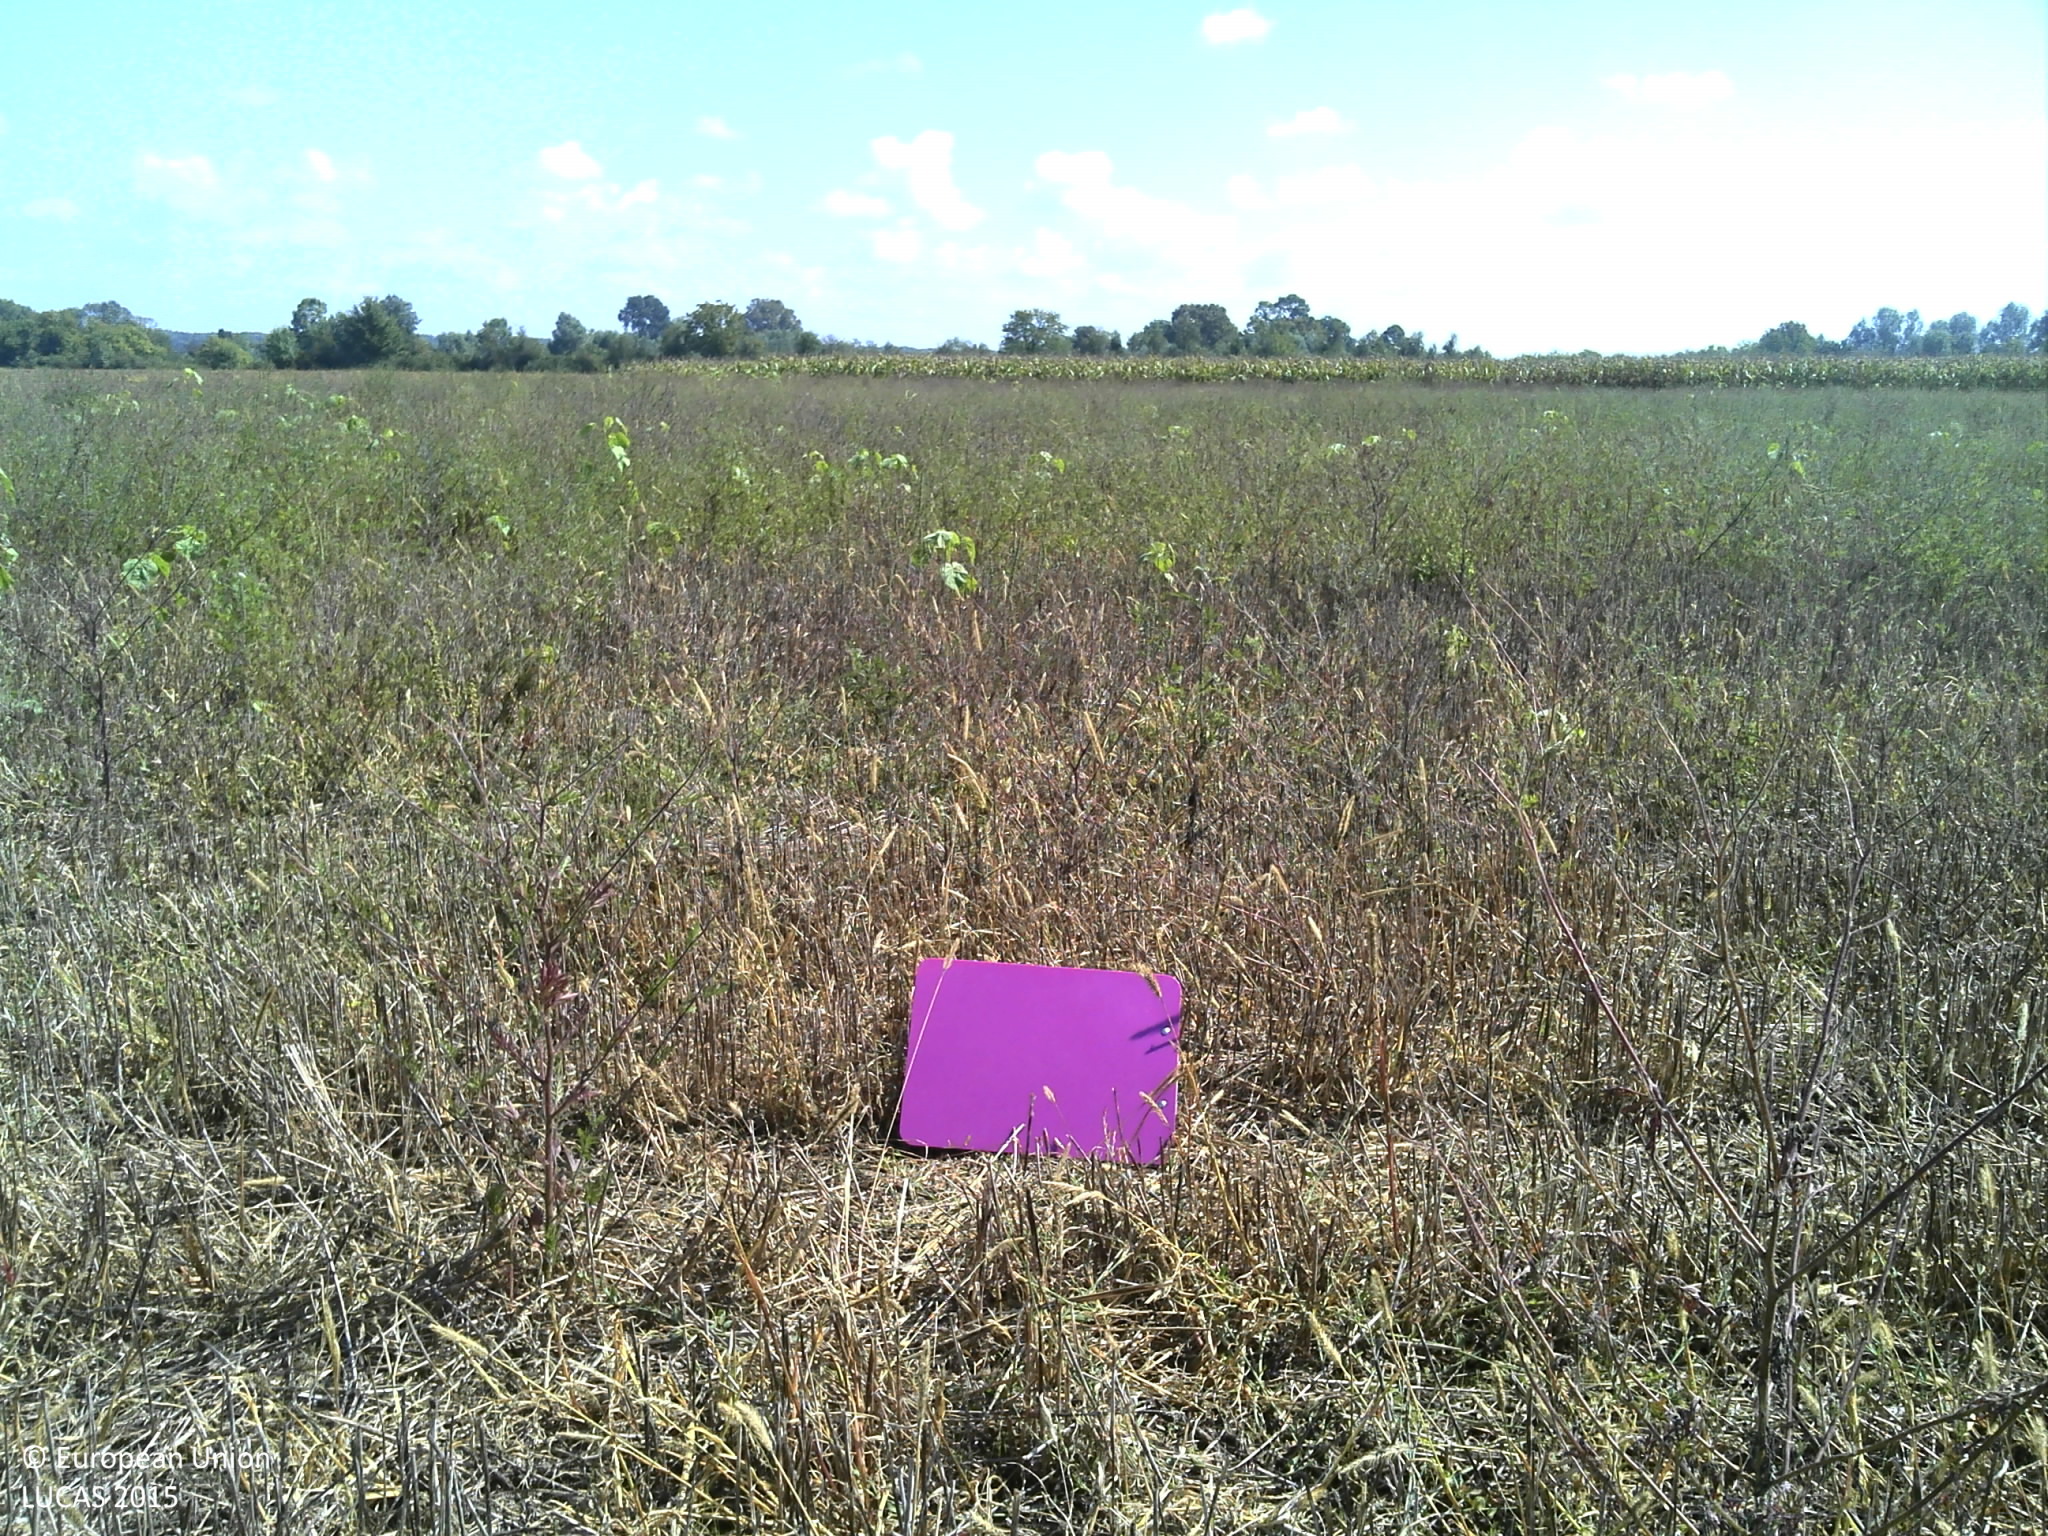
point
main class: Cropland
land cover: Common wheat
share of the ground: > 75 %
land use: Agriculture (excluding fallow land and kitchen gardens)
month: September
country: HR
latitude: 45.1358
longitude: 18.5885
